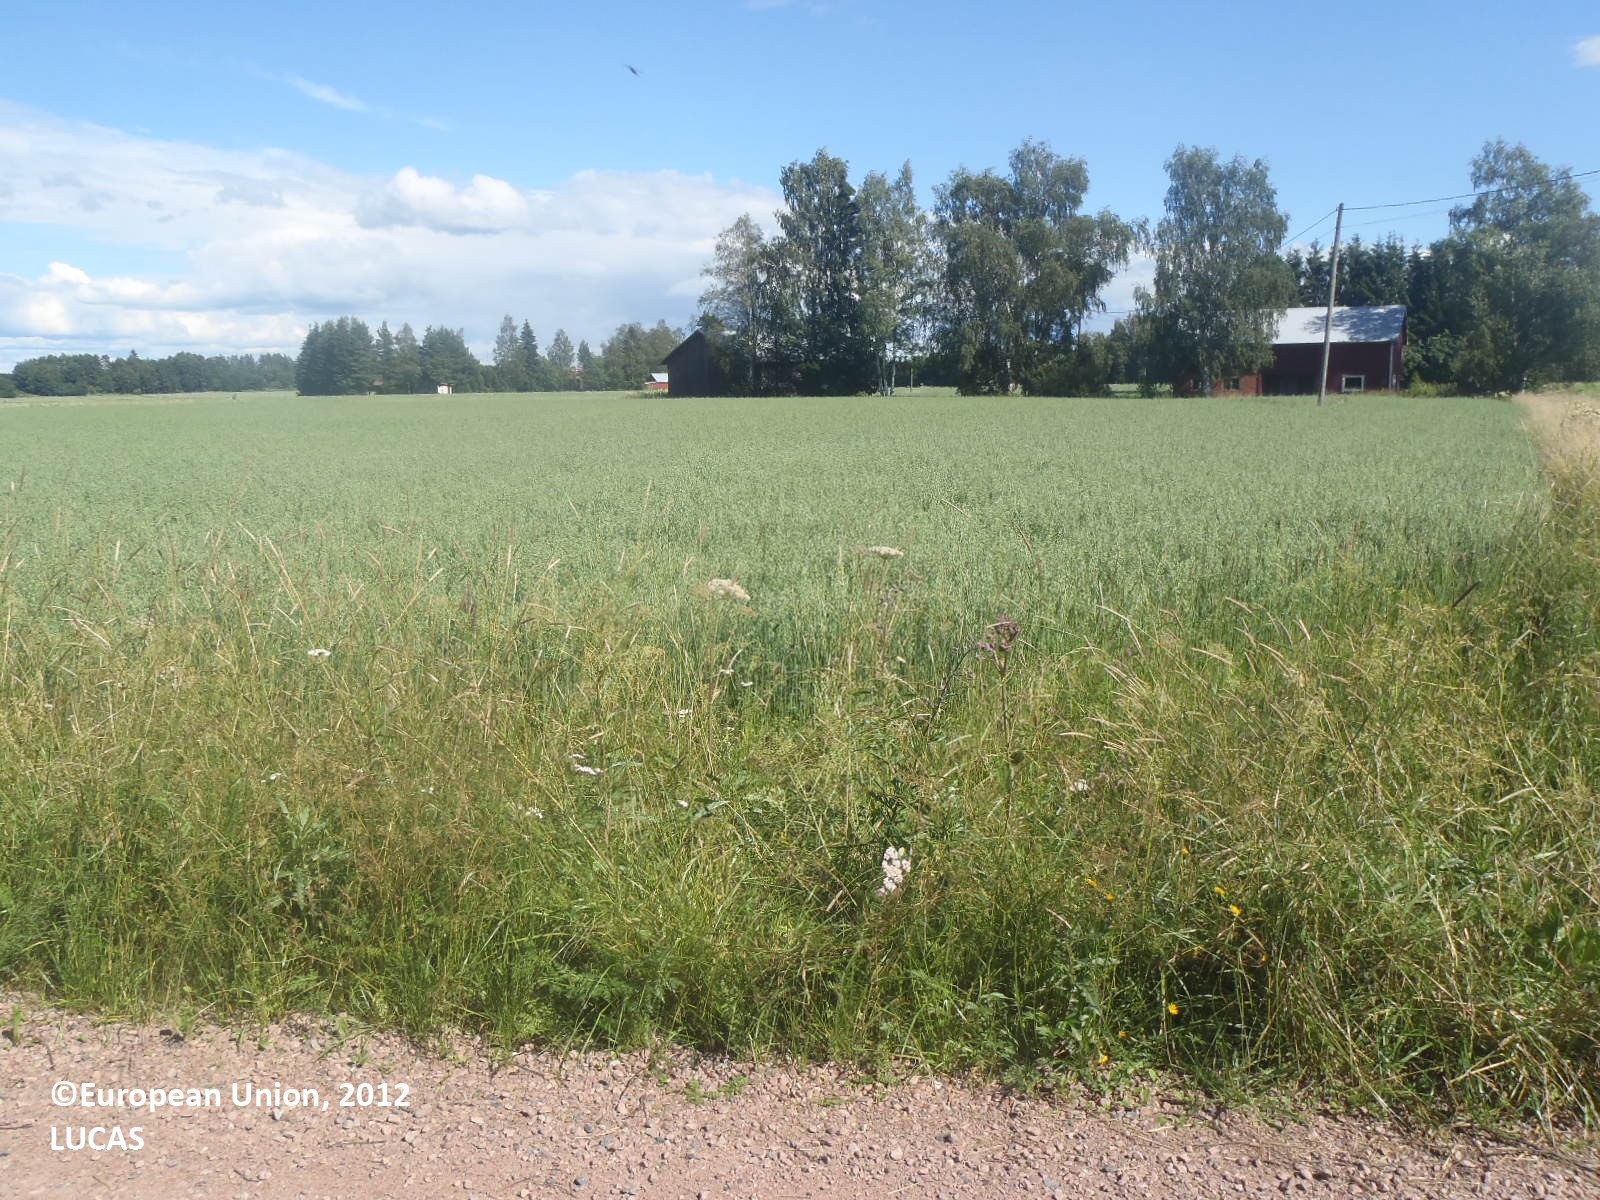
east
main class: Woodland
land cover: Spruce dominated coniferous woodland
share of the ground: > 75 %
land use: Residential
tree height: < 5 m
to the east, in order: Conifer hedges; Grass margins; Paved roads, cycling and walking lanes; Grass margins; Ditches and canals; Grass margins; Oats; Broadleaved woodland; Artificial constructions in urban areas; Grass margins; Oats; Electric lines; Oats
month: July
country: FI
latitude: 61.1940
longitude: 22.0593
